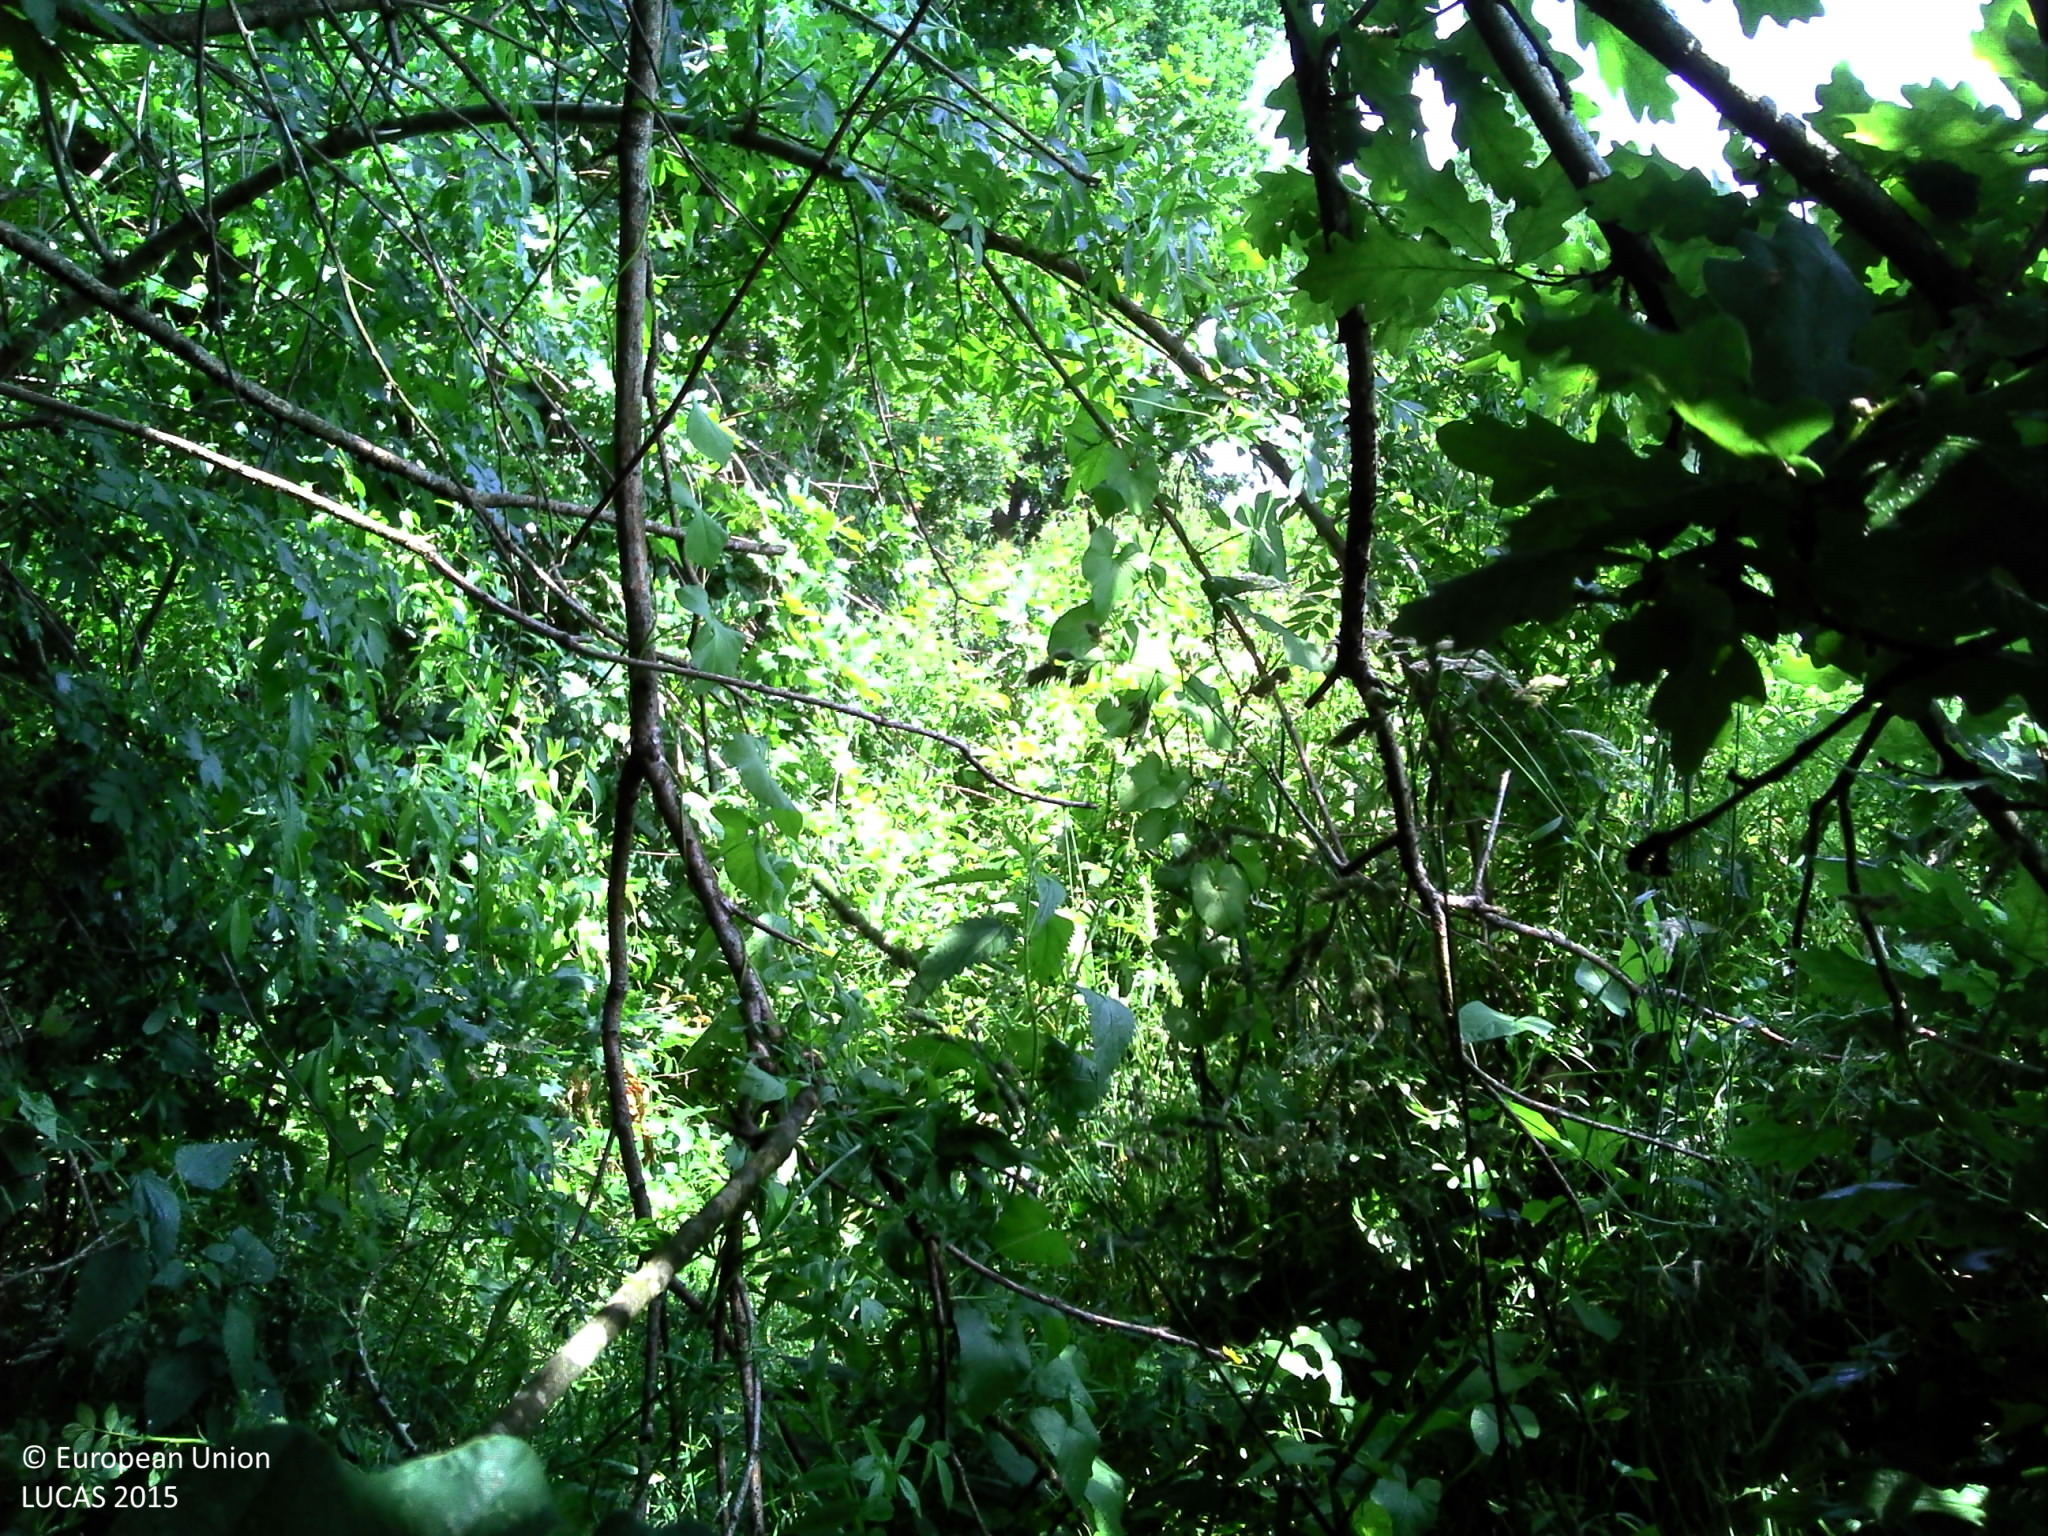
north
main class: Woodland
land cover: Broadleaved woodland
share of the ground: > 75 %
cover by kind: broadleaved forest trees 95 %, shrubs 5 %
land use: Semi-natural and natural areas not in use
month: June
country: FR
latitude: 47.1468
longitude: -1.5008
